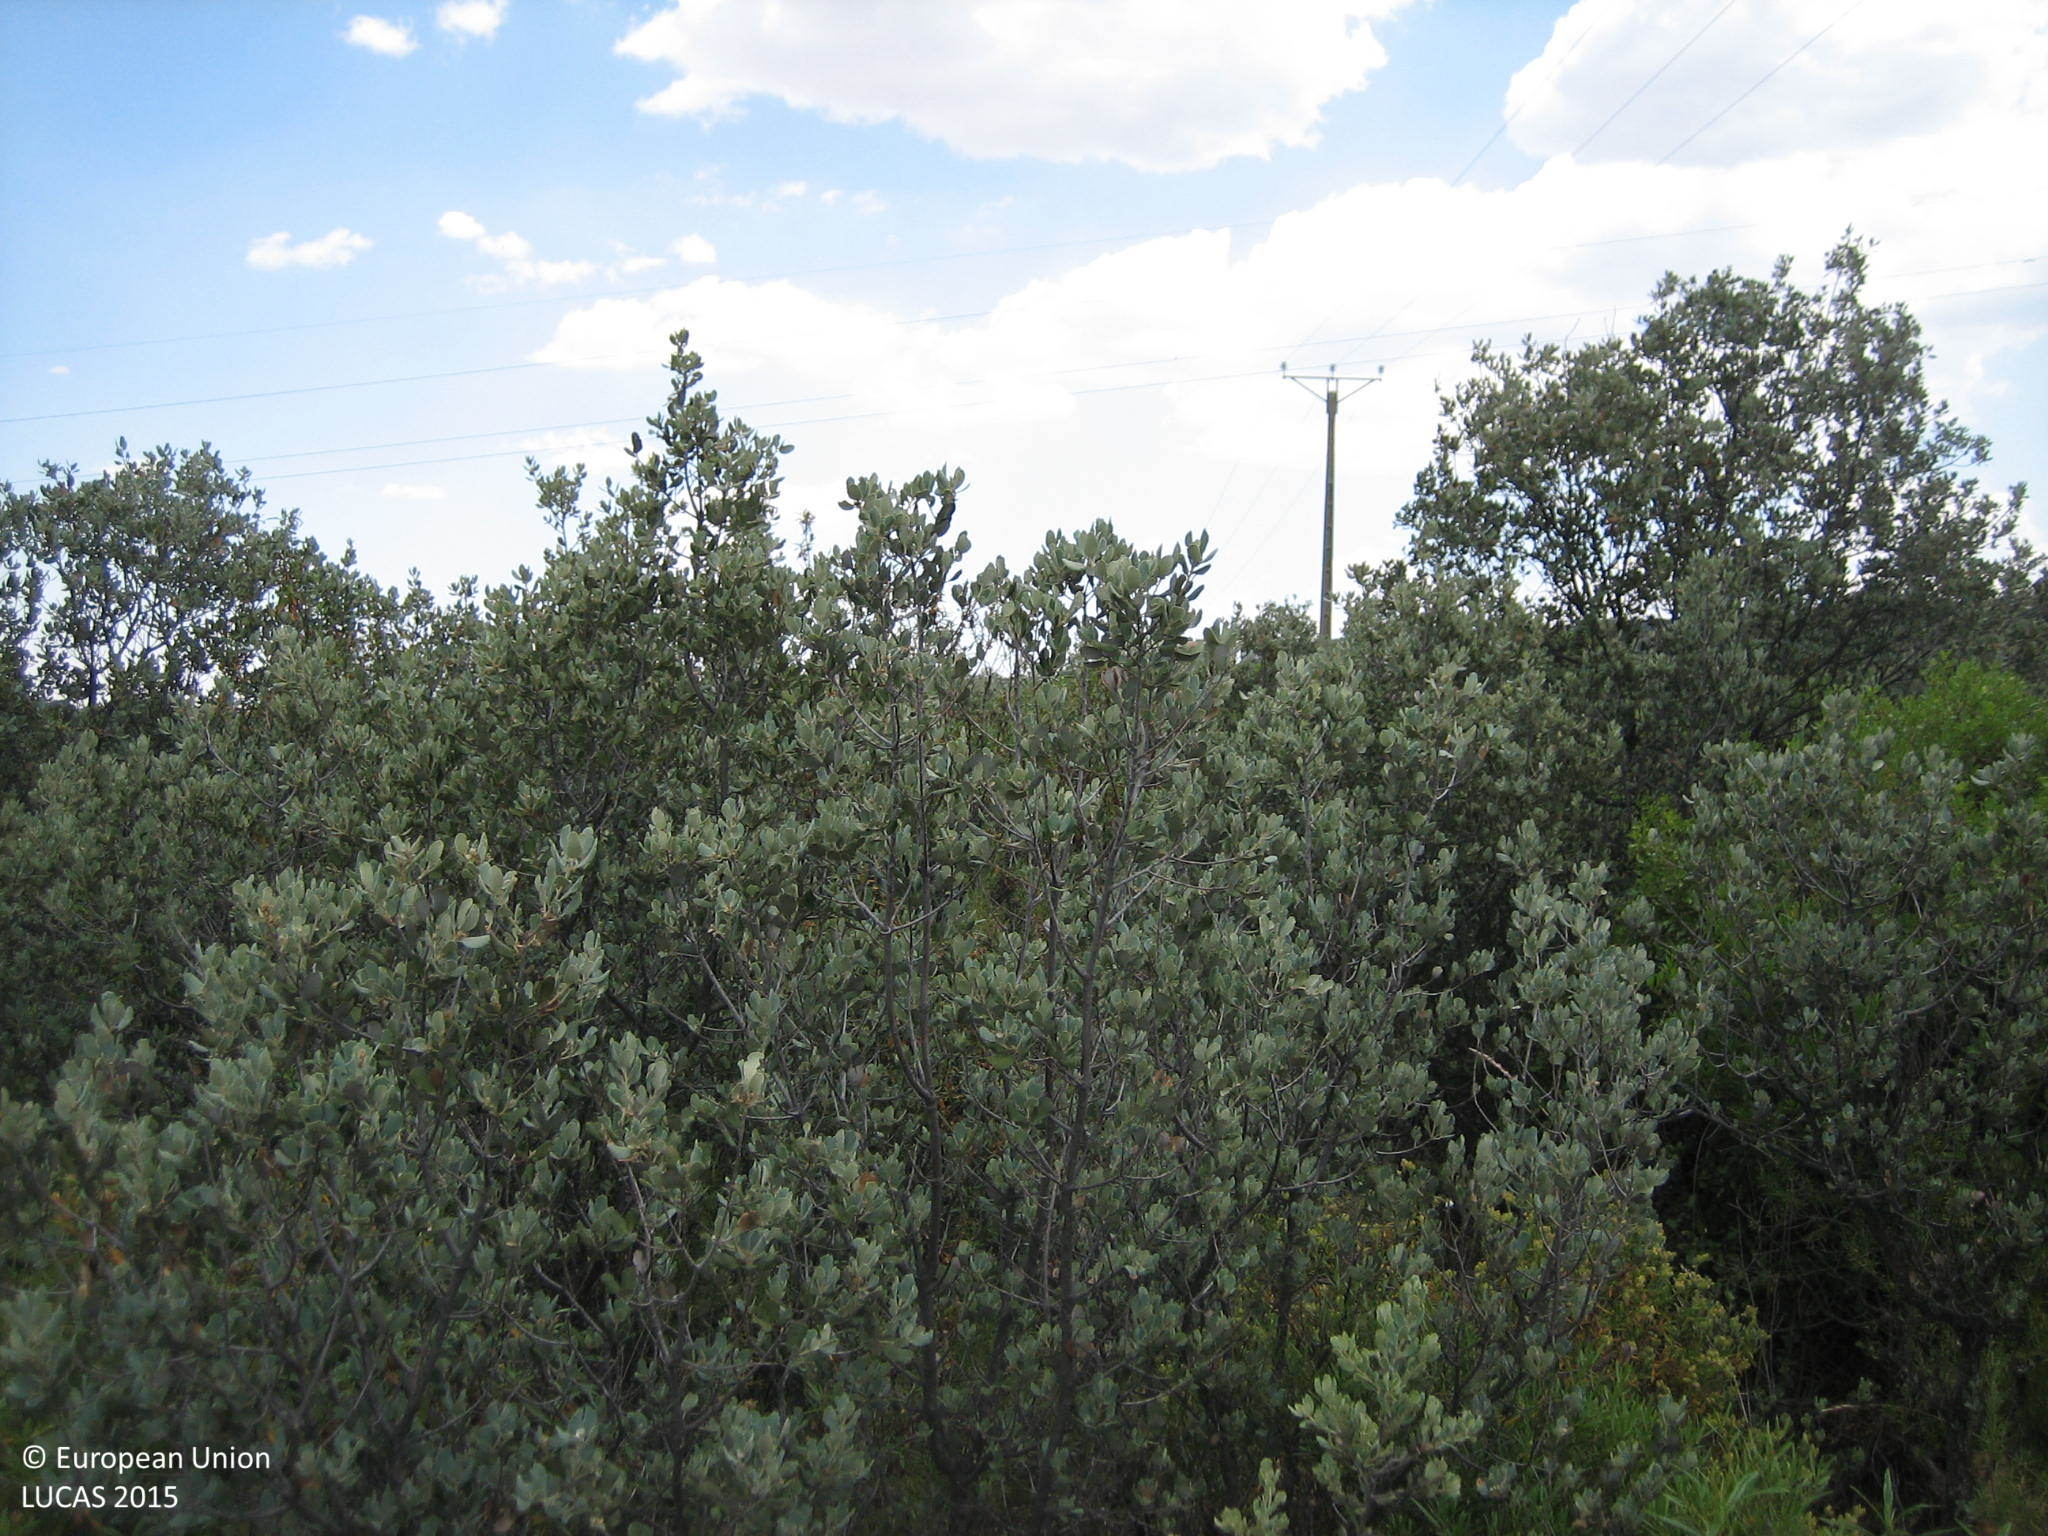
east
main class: Shrubland
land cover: Shrubland with sparse tree cover
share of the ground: > 75 %
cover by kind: shrubs 95 %, broadleaved forest trees 5 %
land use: Semi-natural and natural areas not in use
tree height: < 5 m
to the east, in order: Shrubland with sparse tree cover; Electric lines; Shrubland with sparse tree cover
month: May
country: ES
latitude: 38.8383
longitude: -4.1102
